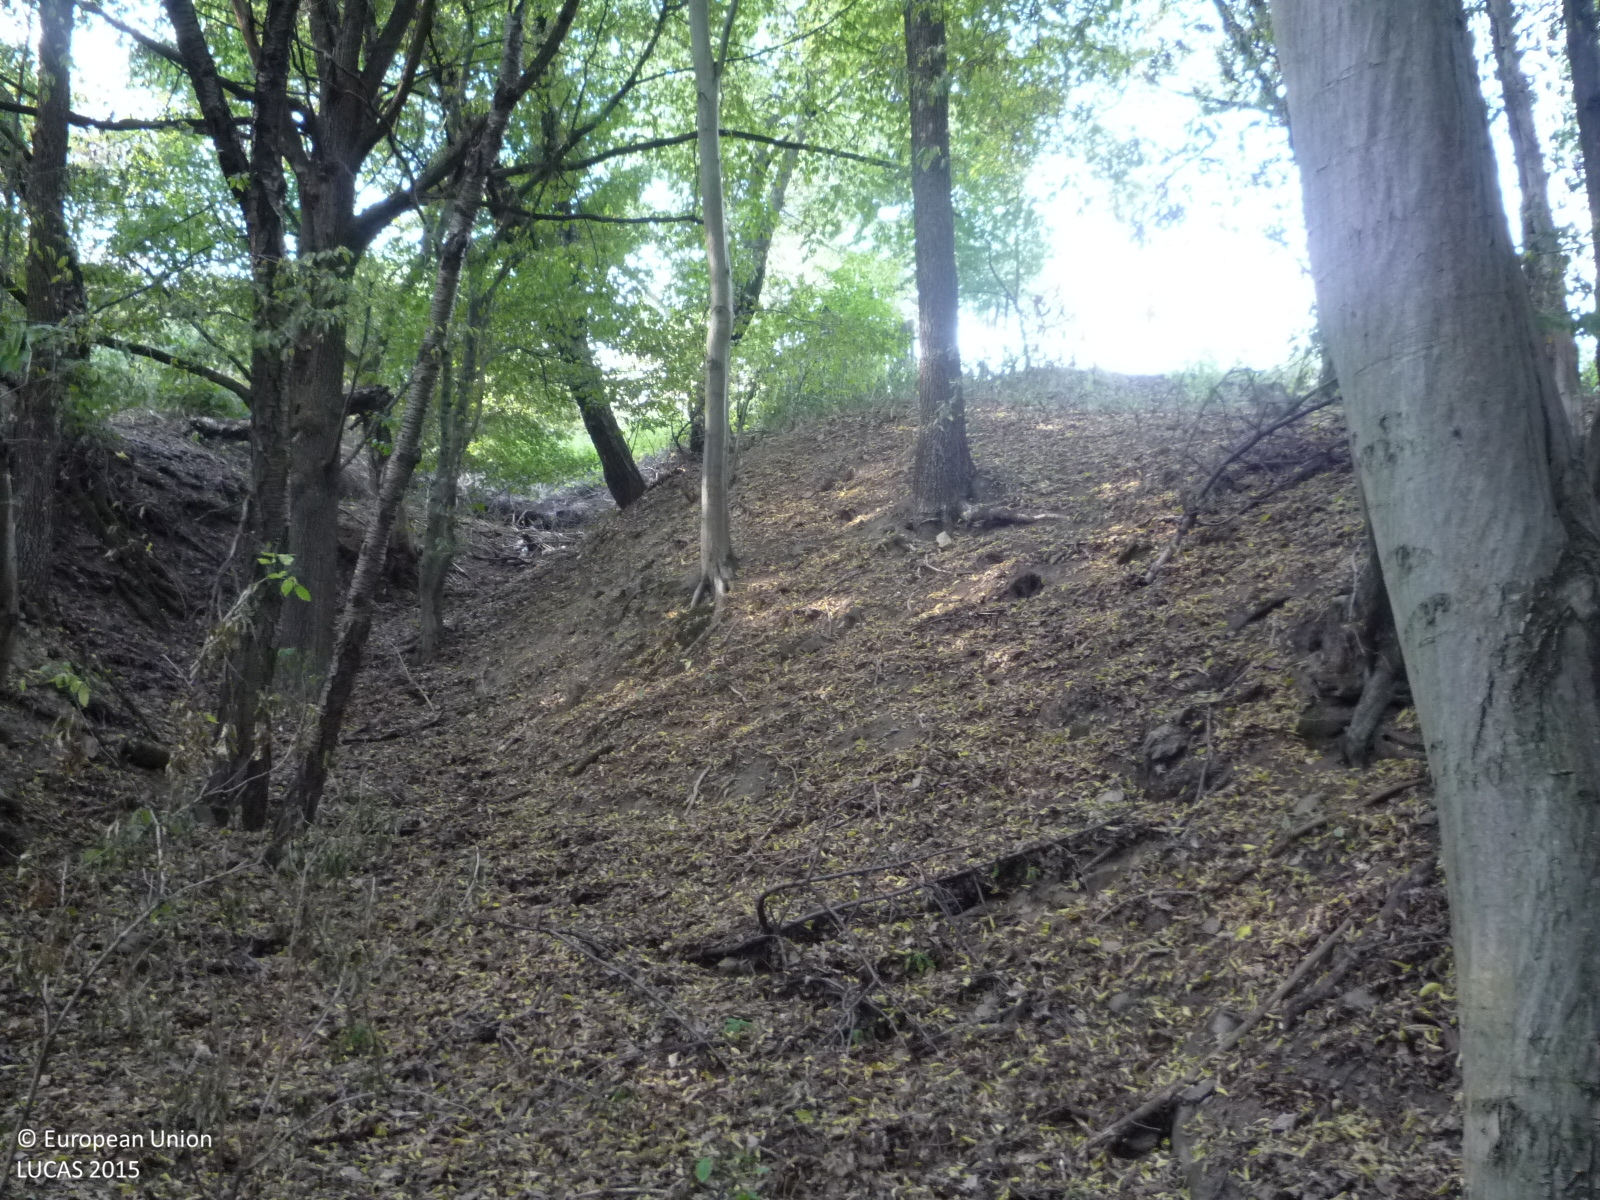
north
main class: Woodland
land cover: Broadleaved woodland
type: mesophytic deciduous forest
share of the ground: > 75 %
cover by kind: broadleaved forest trees 95 %, unconsolidated bare surface 5 %
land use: Forestry
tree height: > 5 m
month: August
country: CZ
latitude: 49.8267
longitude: 14.4638
